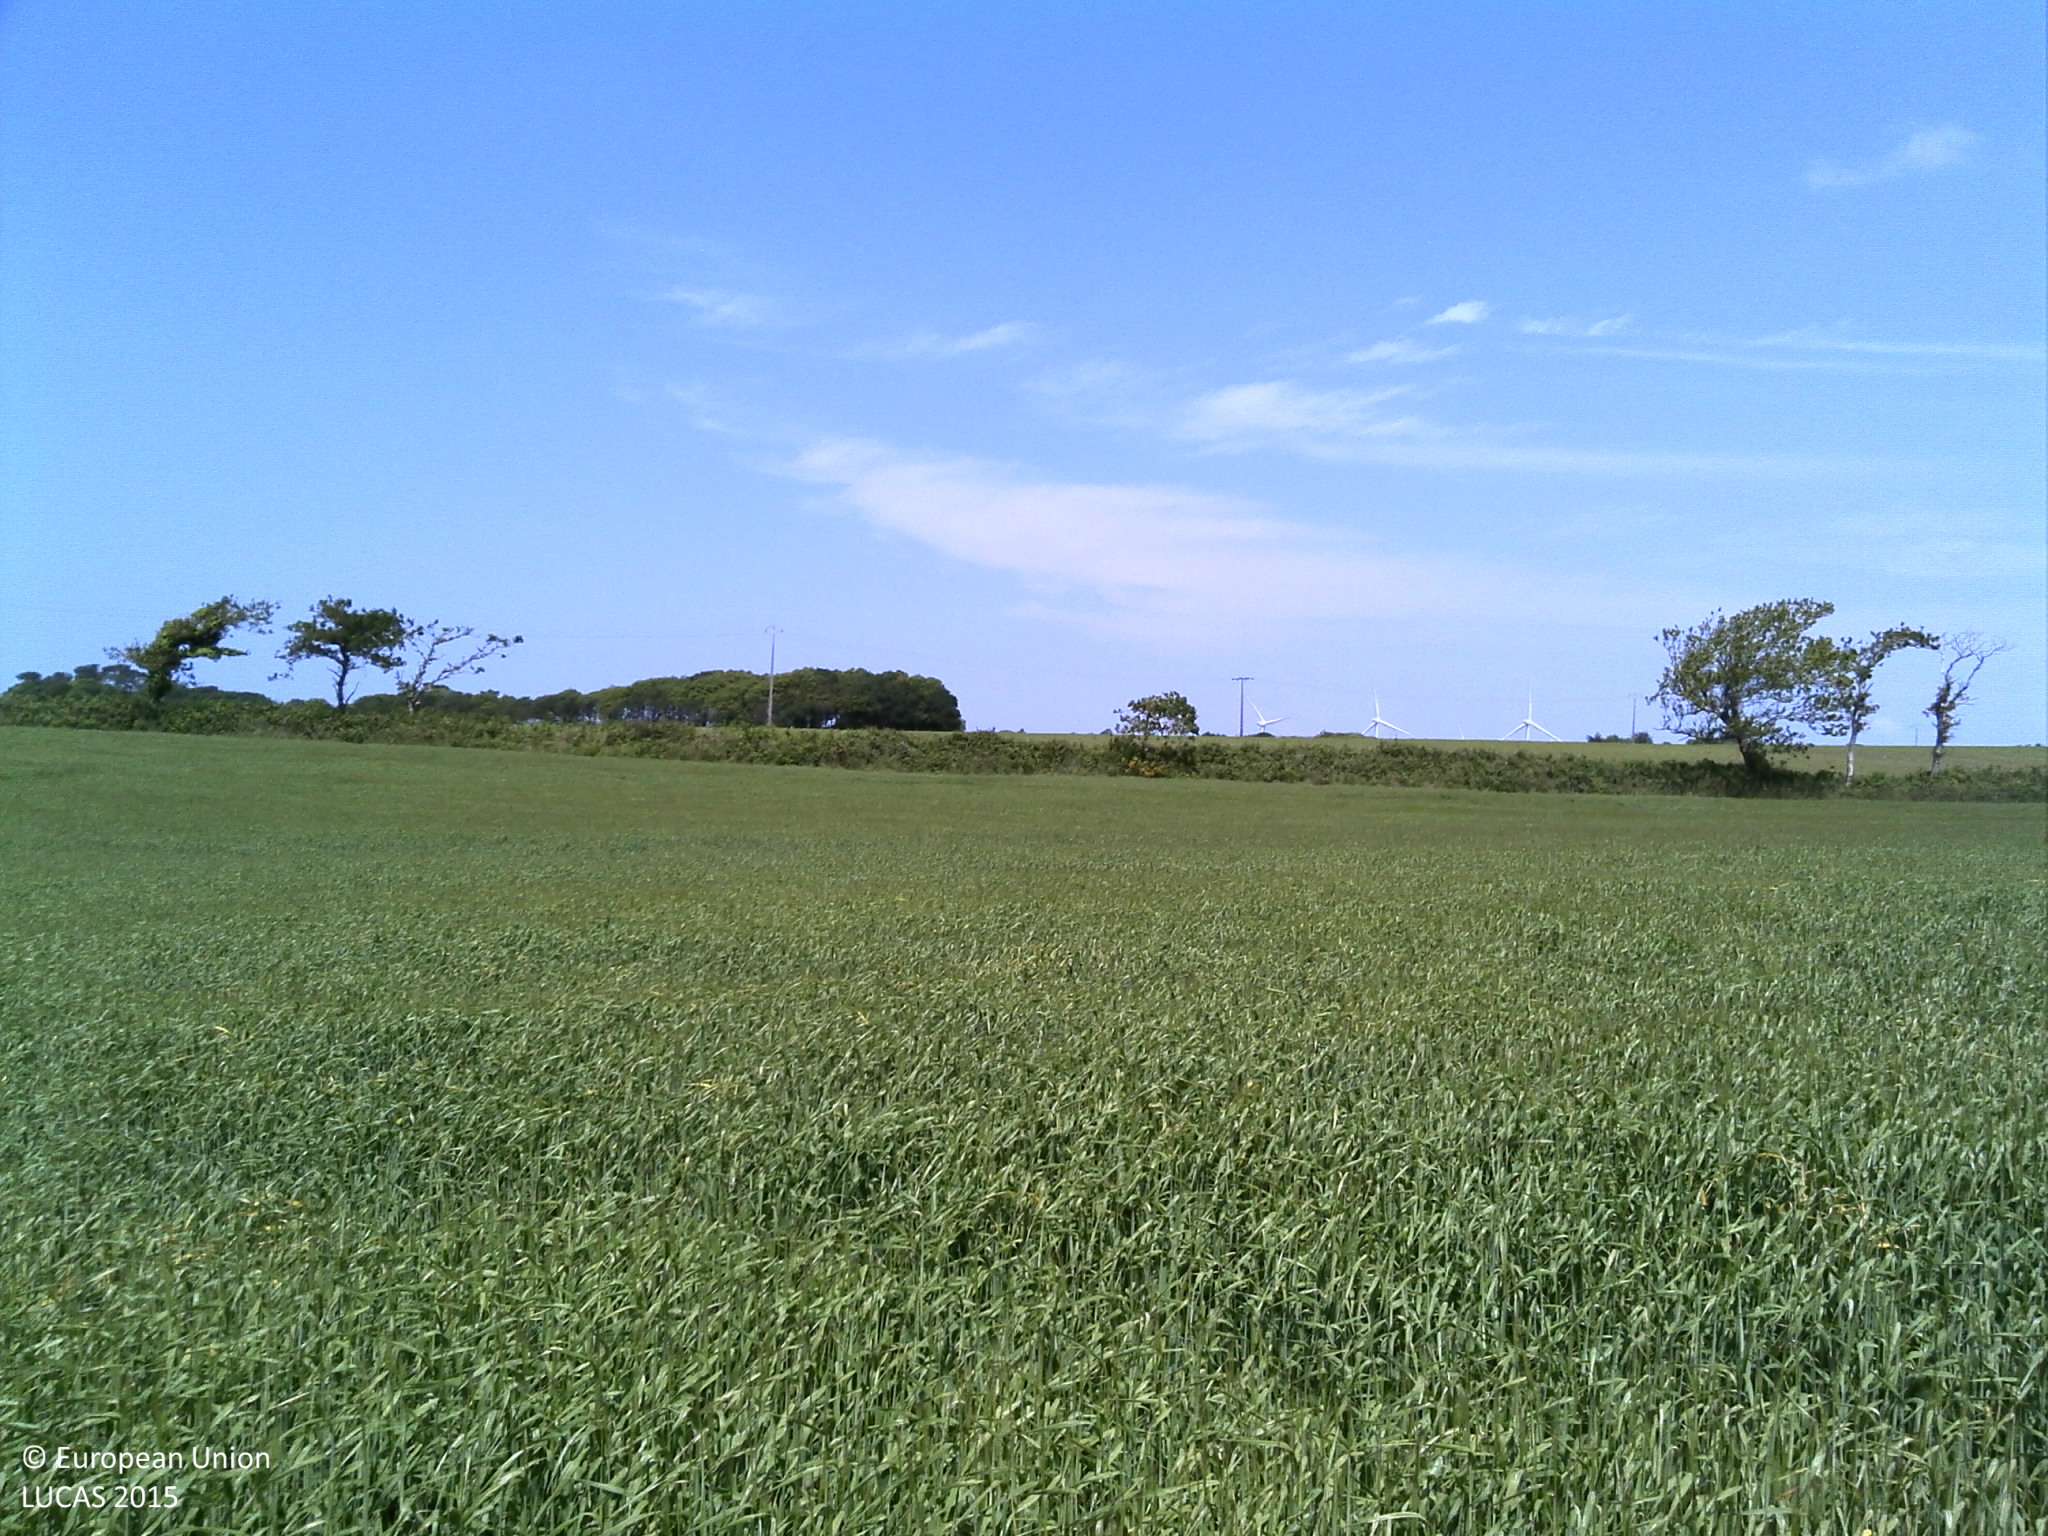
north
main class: Cropland
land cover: Barley
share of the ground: > 75 %
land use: Agriculture (excluding fallow land and kitchen gardens)
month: June
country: FR
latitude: 47.9858
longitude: -4.3908
